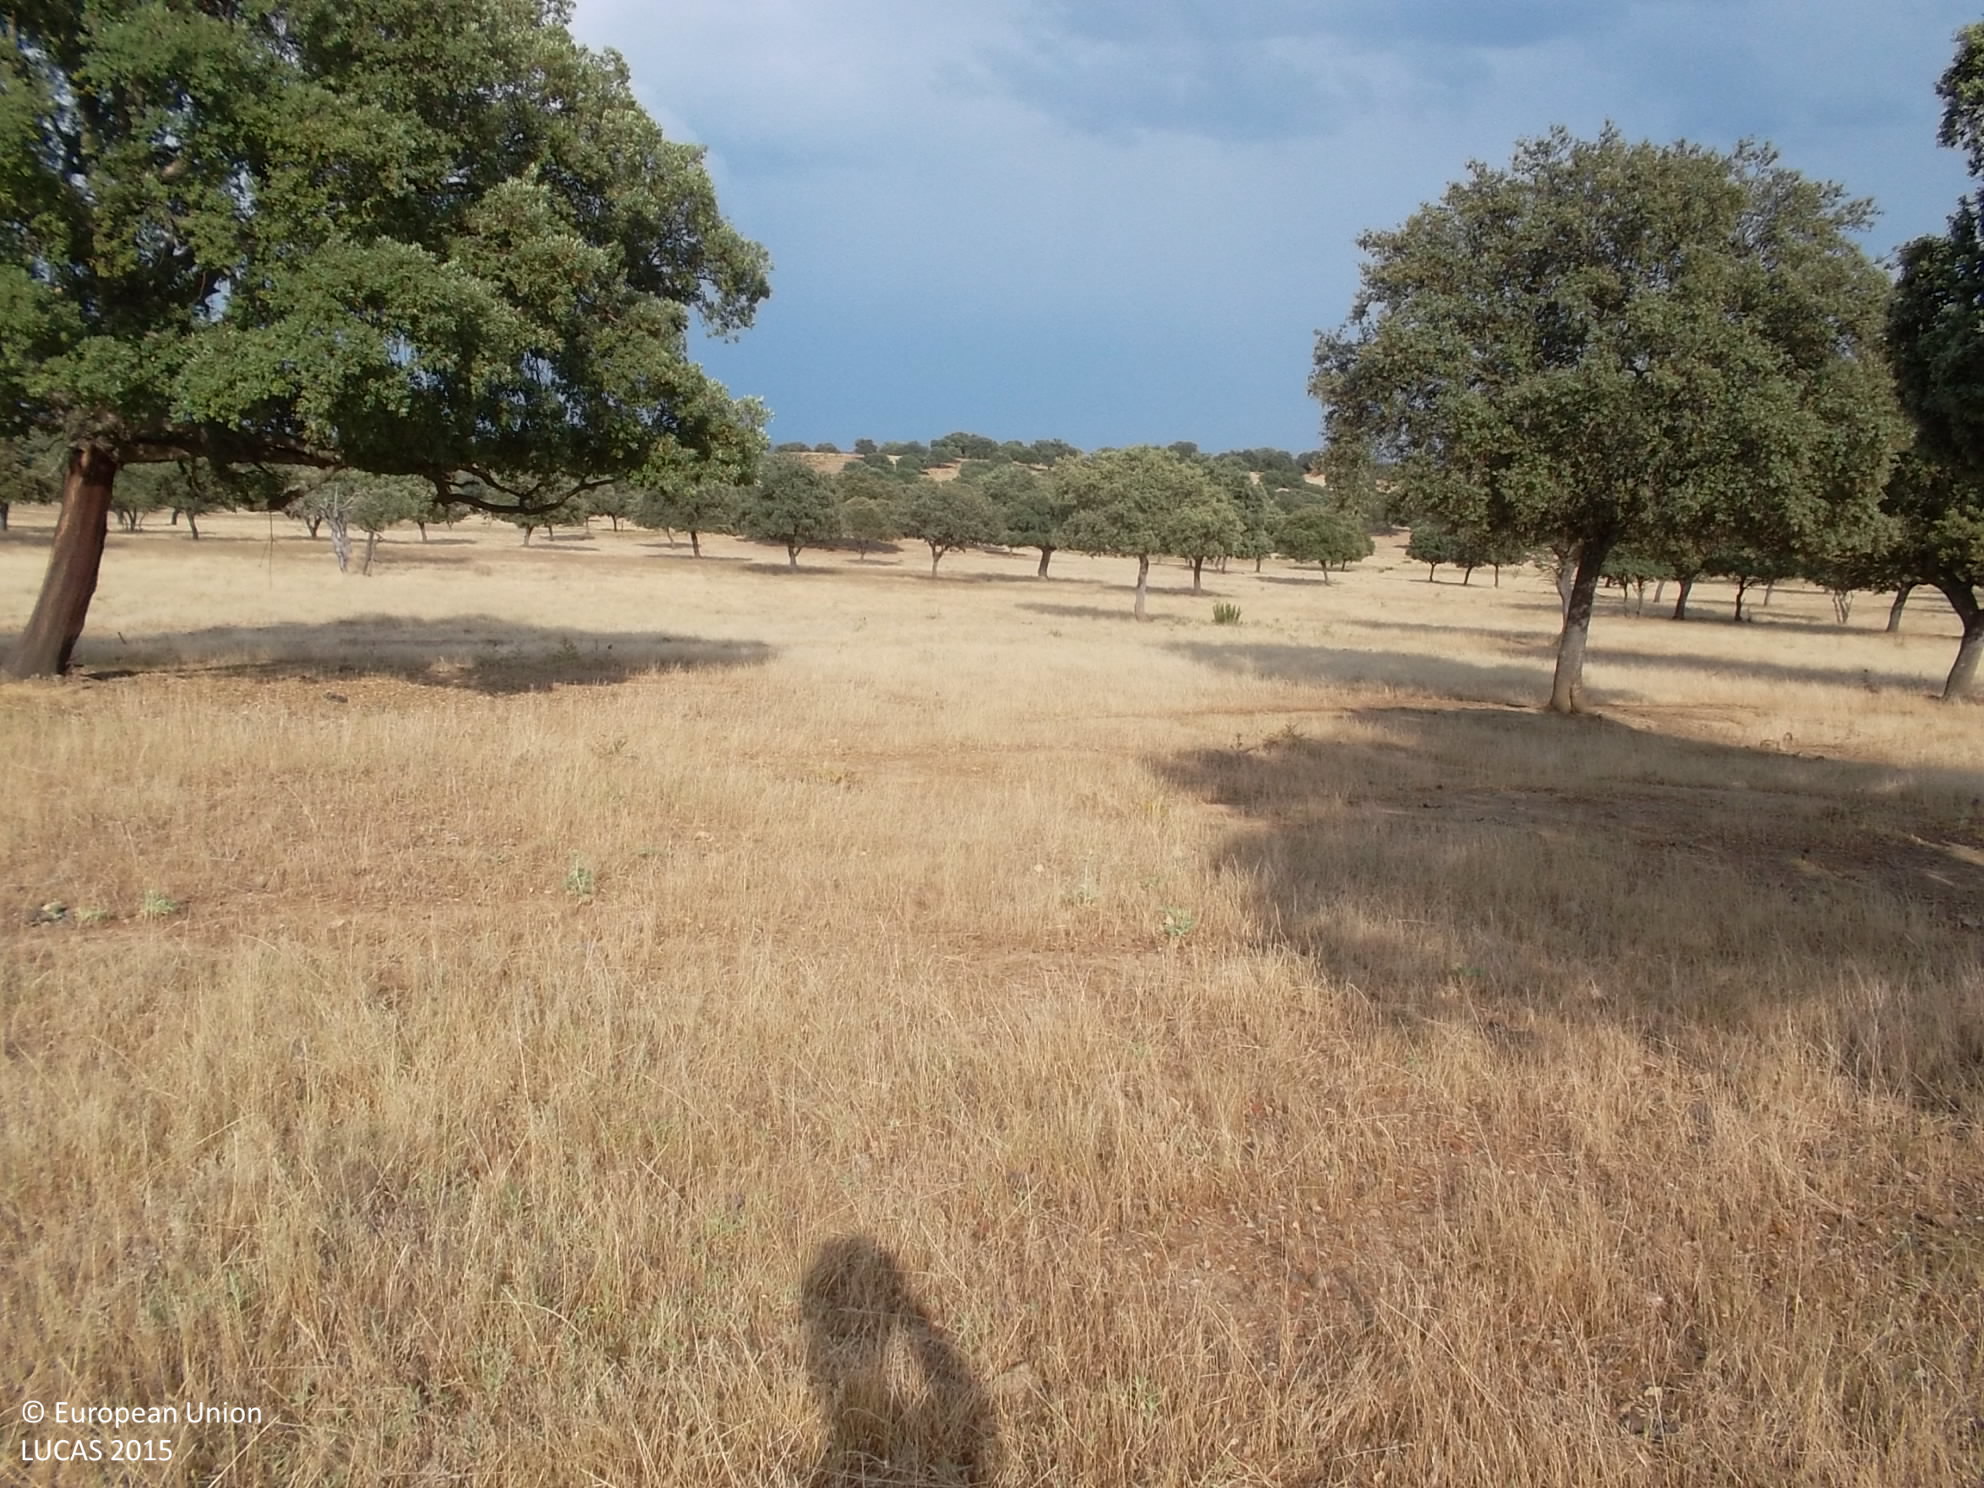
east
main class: Woodland
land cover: Broadleaved woodland
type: broadleaved evergreen forest
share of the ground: 25 - 50 %
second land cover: Spontaneously vegetated surfaces
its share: > 75 %
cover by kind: herbaceous plants 60 %, broadleaved forest trees 40 %
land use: Forestry
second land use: Agriculture (excluding fallow land and kitchen gardens)
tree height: > 5 m
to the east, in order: Broadleaved woodland; Spontaneously vegetated surfaces
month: June
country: ES
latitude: 39.2467
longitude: -4.9278
